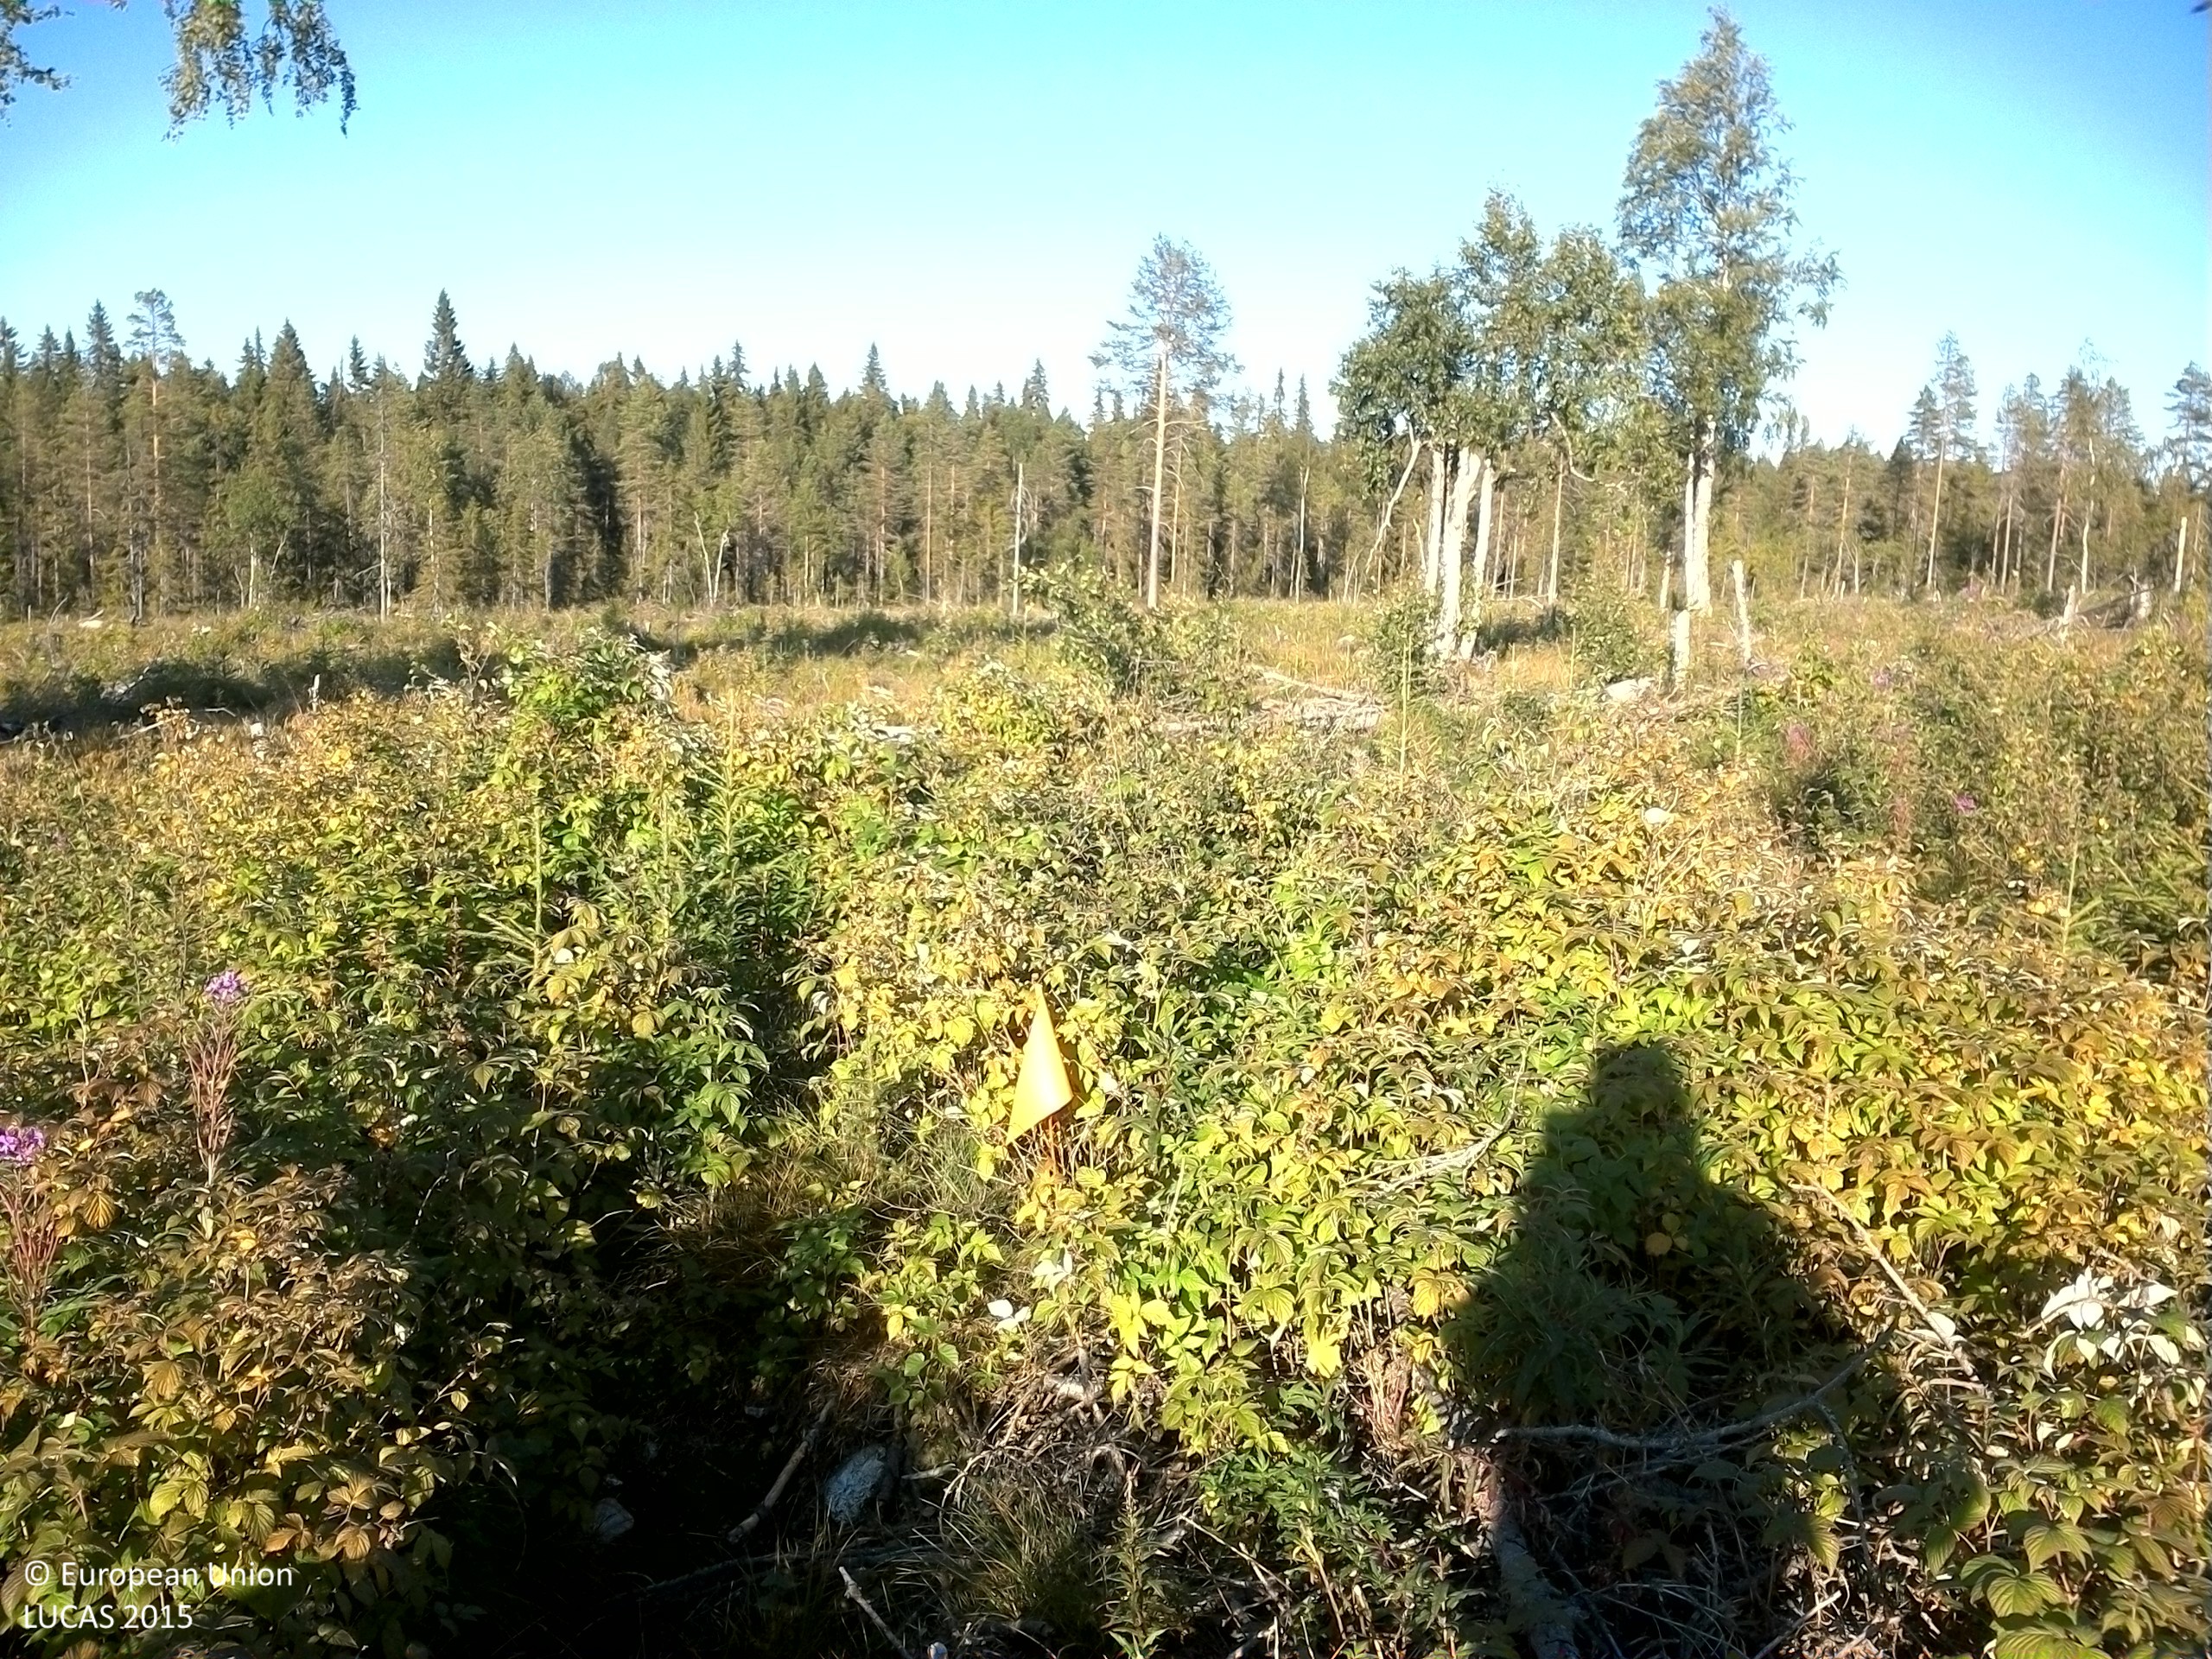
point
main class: Shrubland
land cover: Shrubland with sparse tree cover
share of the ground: > 75 %
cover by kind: shrubs 80 %, herbaceous plants 10 %, broadleaved forest trees 5 %, lichens and mosses 5 %
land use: Forestry
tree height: < 5 m
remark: Clear cut
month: August
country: SE
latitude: 63.8985
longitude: 17.4071
